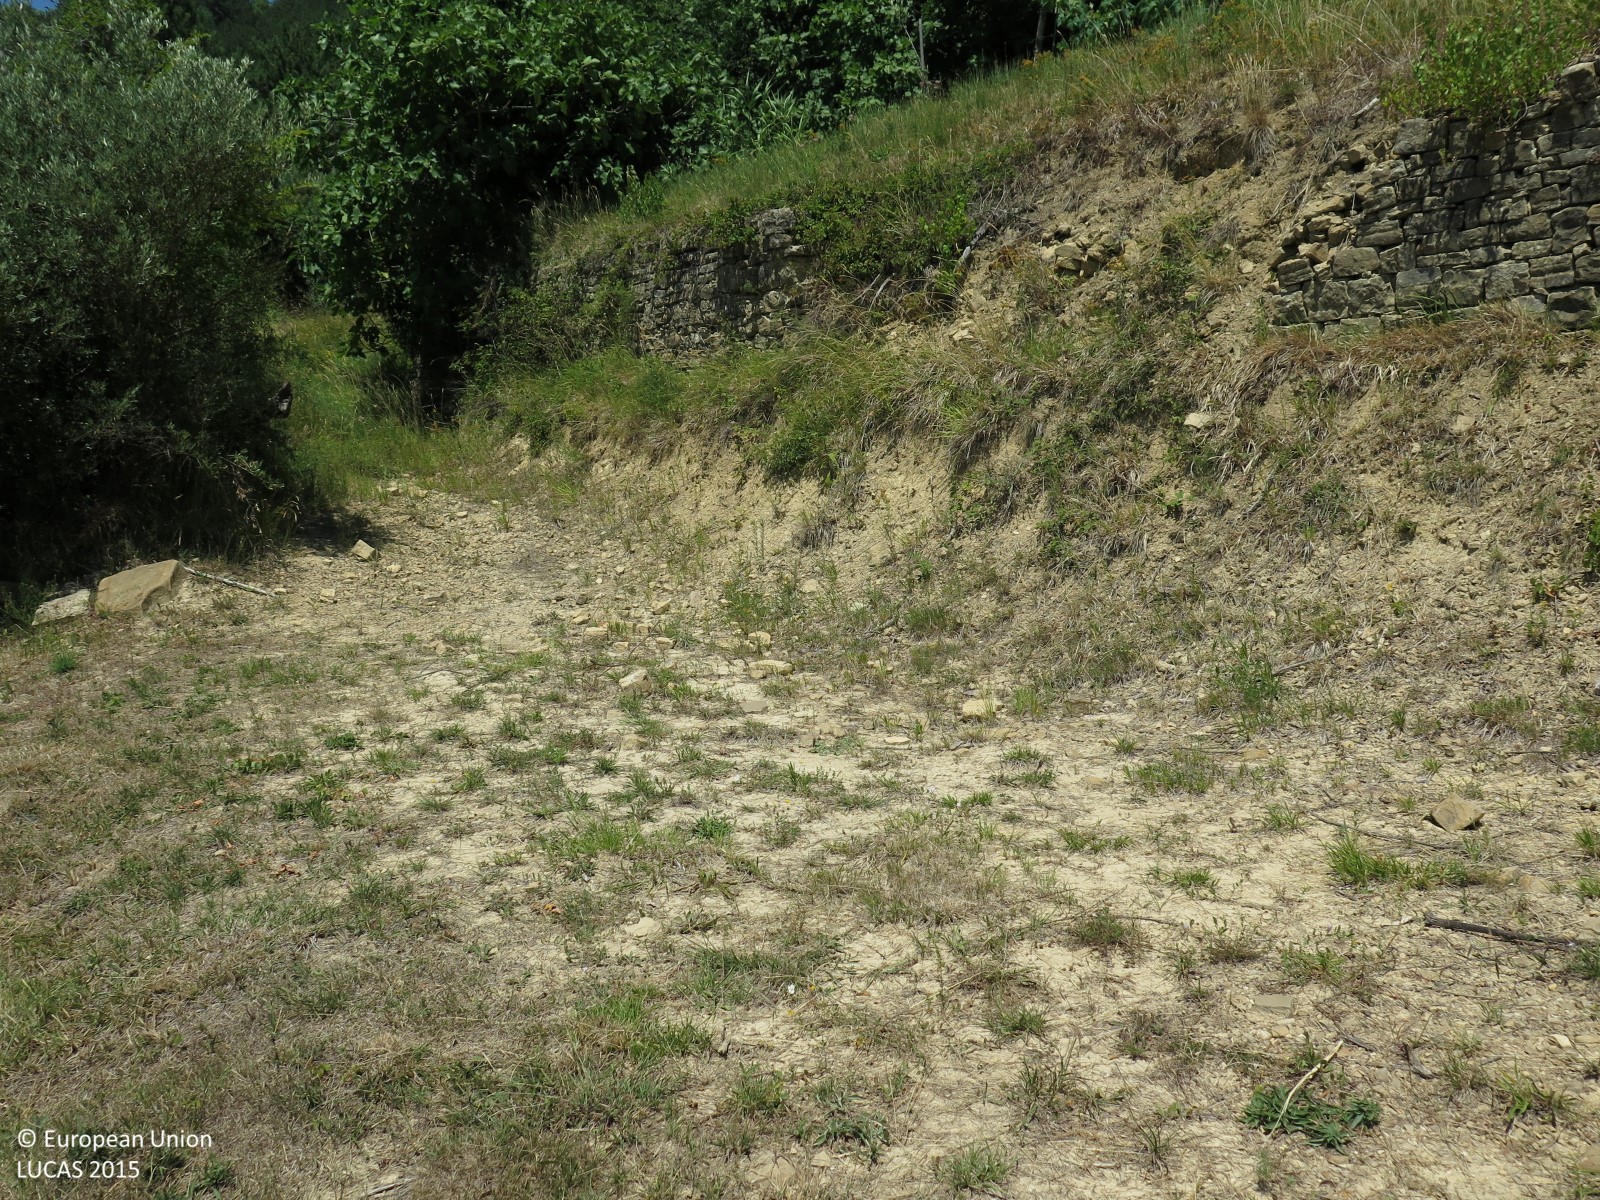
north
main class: Woodland
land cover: Pine dominated mixed woodland
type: coniferous forest of the mediterranean region
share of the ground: > 75 %
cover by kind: coniferous forest trees 75 %, broadleaved forest trees 25 %
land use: Semi-natural and natural areas not in use
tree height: > 5 m
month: July
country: HR
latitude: 45.3625
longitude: 13.8378
